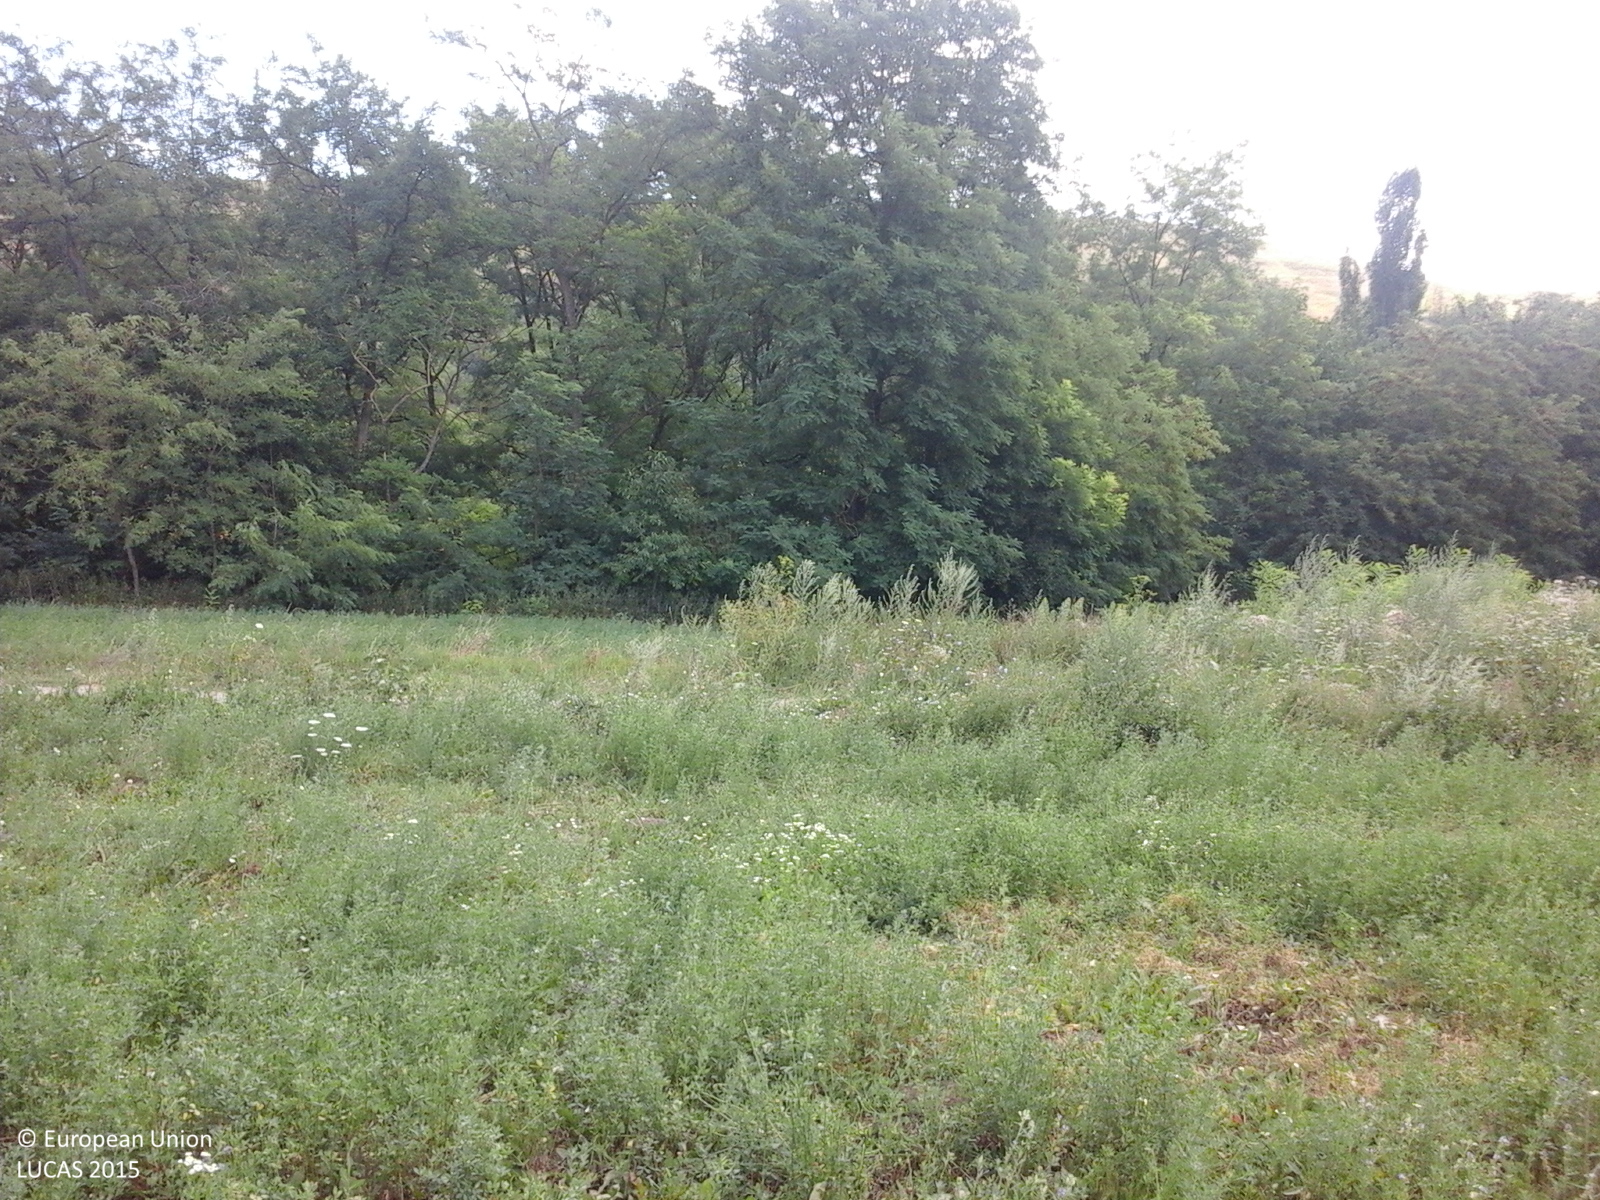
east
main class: Cropland
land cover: Lucerne
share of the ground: > 75 %
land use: Agriculture (excluding fallow land and kitchen gardens)
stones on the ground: < 10 %
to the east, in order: Lucerne; Grass margins; Tracks; Grass margins; Broadleaved woodland; Rivers and streams; Broadleaved woodland; Lucerne; Tracks; Lucerne
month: July
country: RO
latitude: 46.5761
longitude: 27.2360
